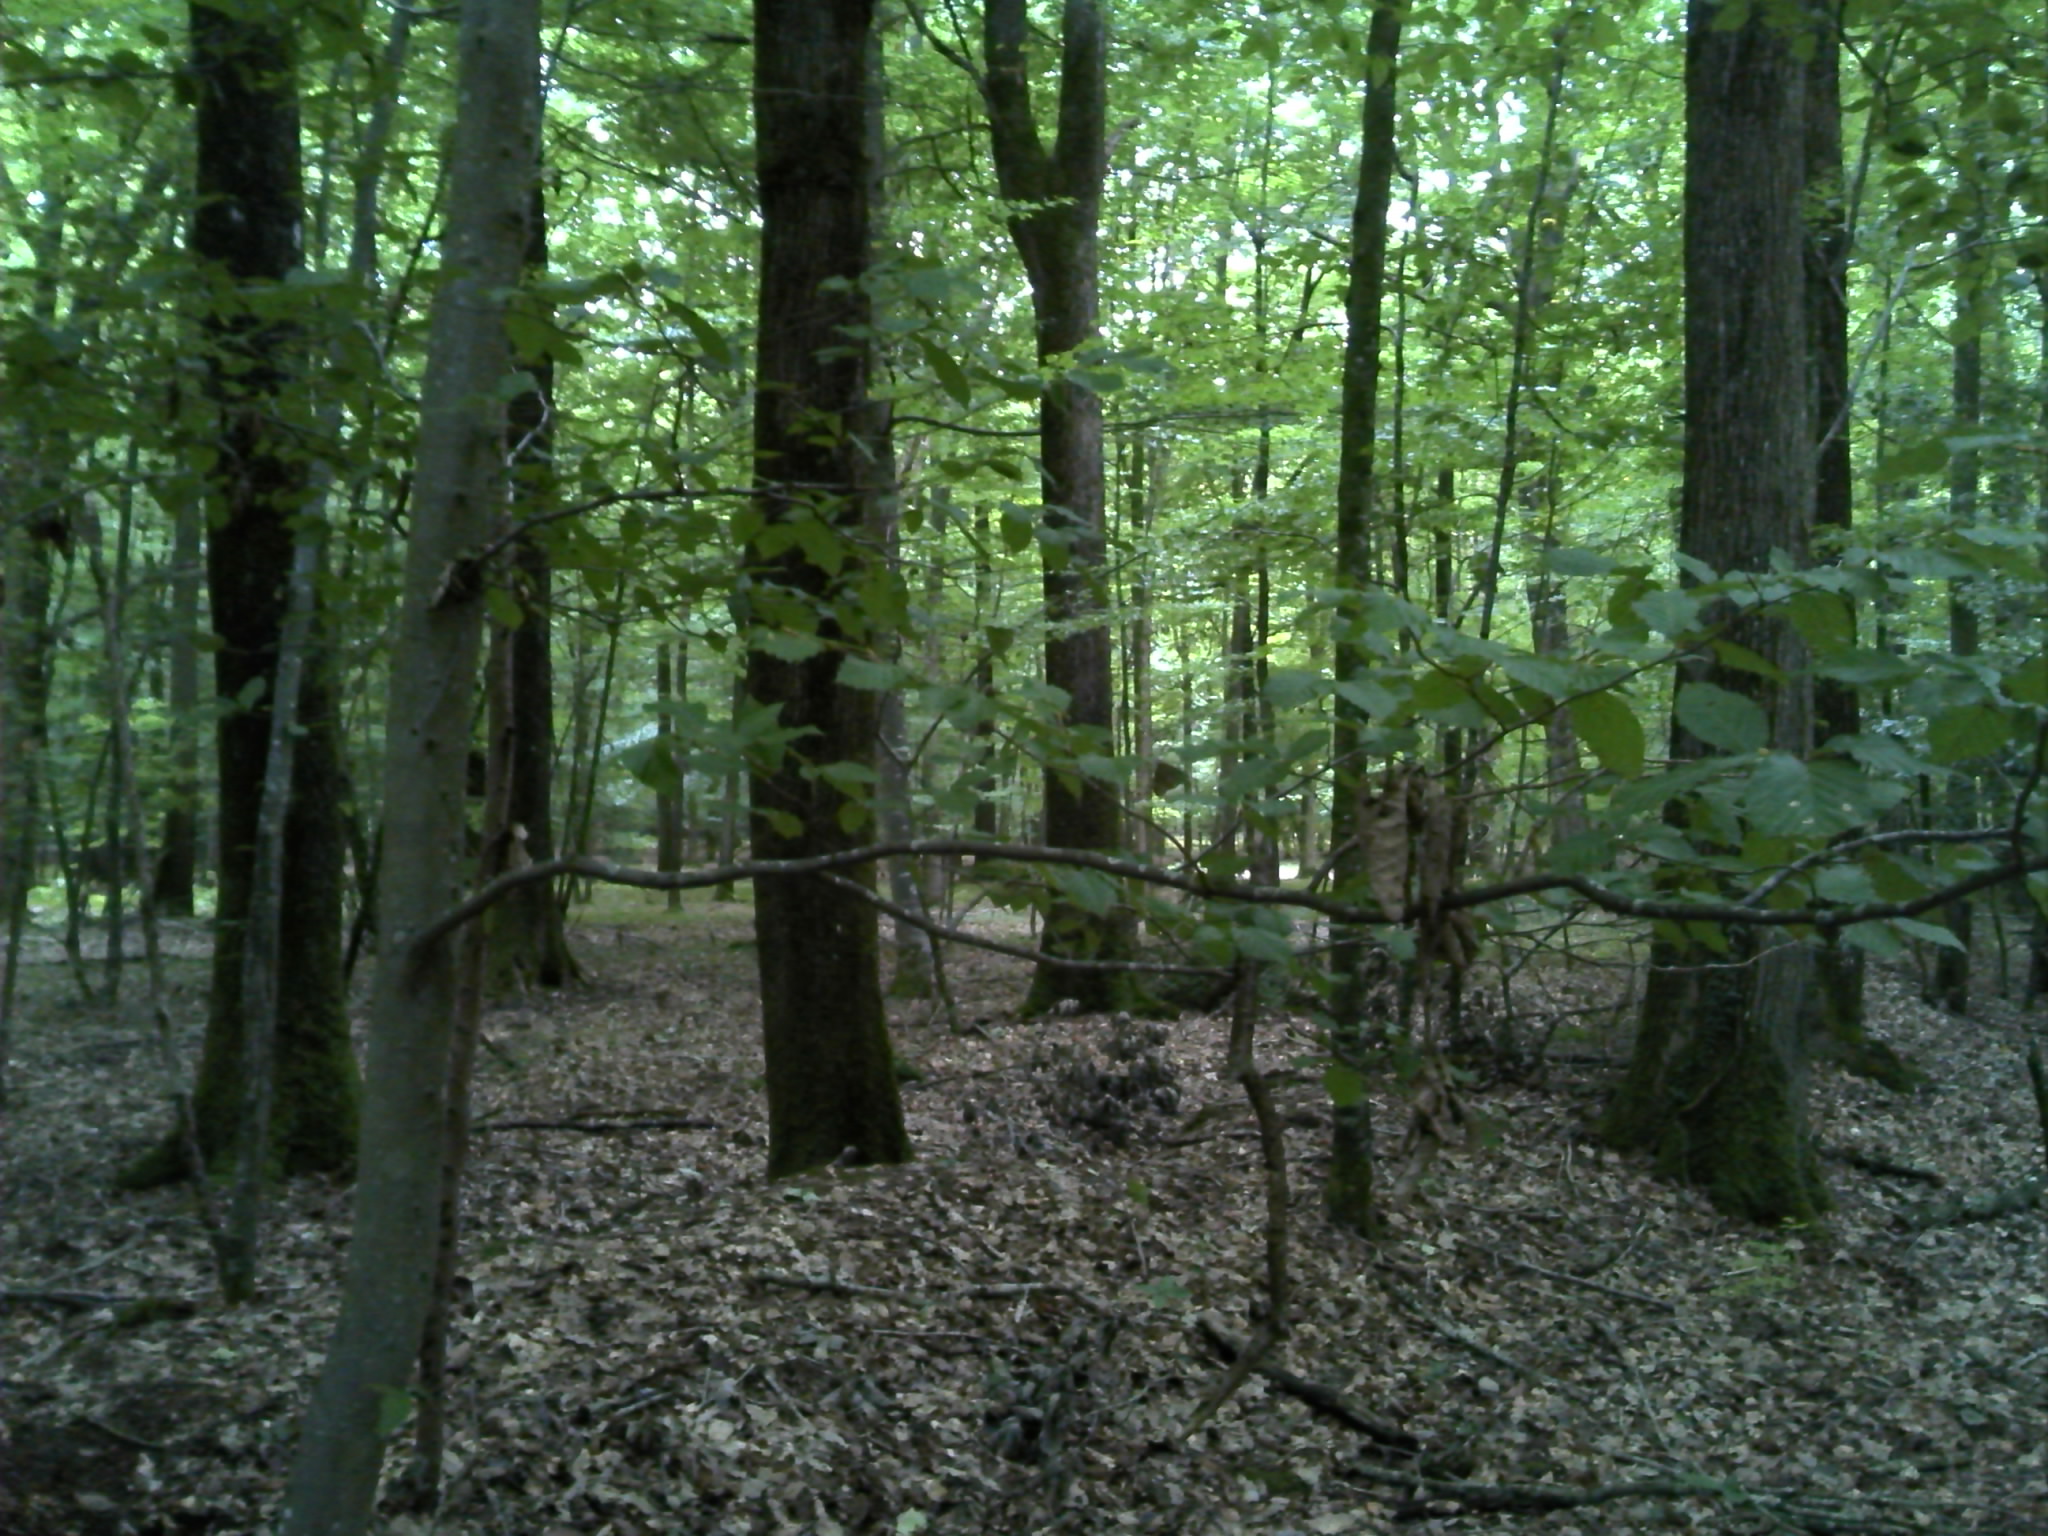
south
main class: Woodland
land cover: Broadleaved woodland
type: beech forest
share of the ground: > 75 %
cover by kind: broadleaved forest trees 95 %, herbaceous plants 5 %
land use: Forestry
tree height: > 5 m
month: September
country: FR
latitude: 48.0098
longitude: 0.6885
